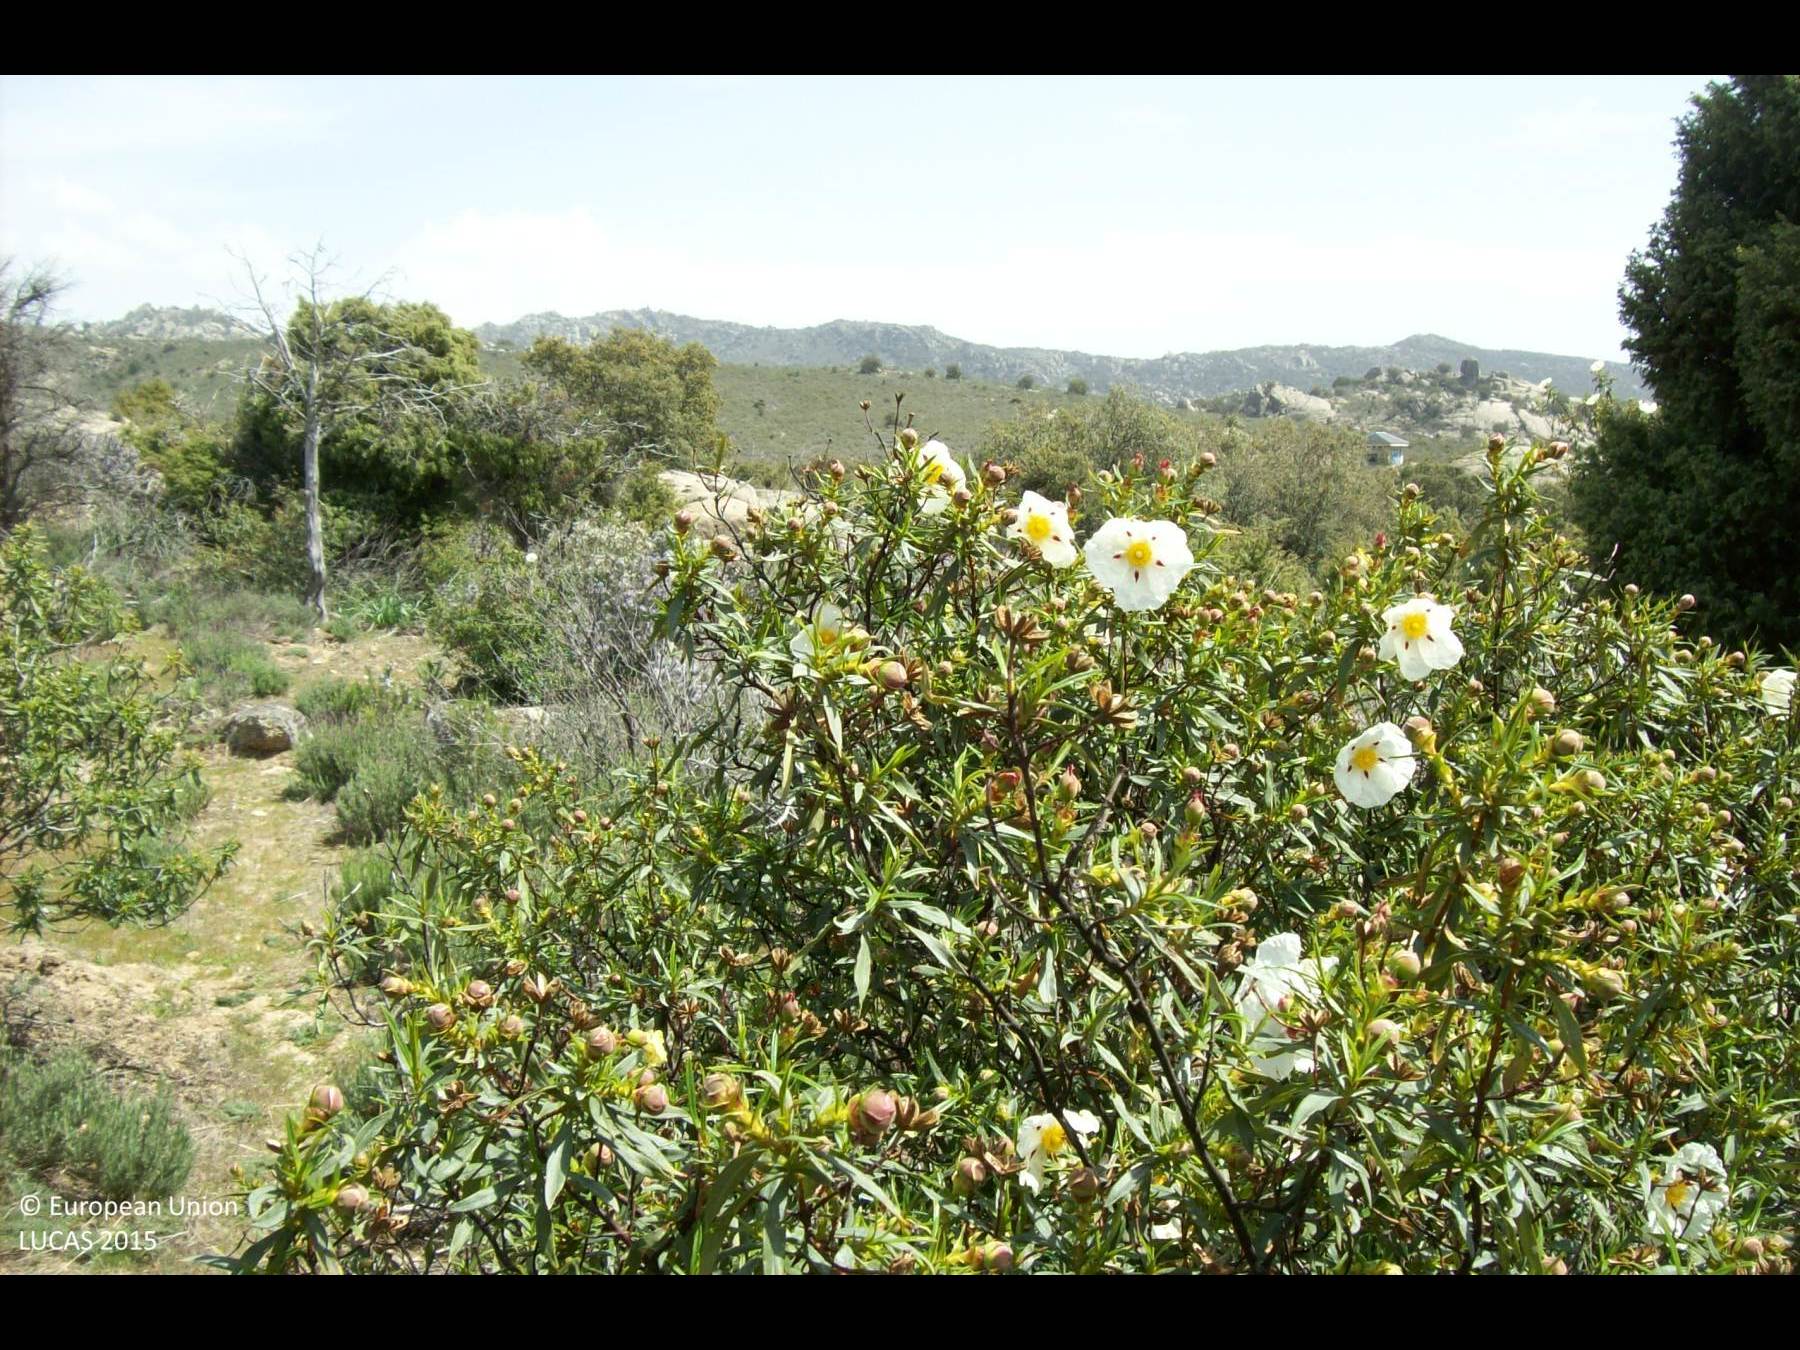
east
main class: Shrubland
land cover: Shrubland with sparse tree cover
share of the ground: > 75 %
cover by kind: consolidated bare surface 40 %, shrubs 35 %, herbaceous plants 20 %, coniferous forest trees 5 %
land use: Semi-natural and natural areas not in use
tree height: < 5 m
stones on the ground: < 10 %
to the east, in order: Shrubland with sparse tree cover; Rock outcrops; Shrubland with sparse tree cover; Tracks; Shrubland with sparse tree cover; Rock outcrops; Shrubland with sparse tree cover
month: April
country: ES
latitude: 40.6381
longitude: -3.9609
